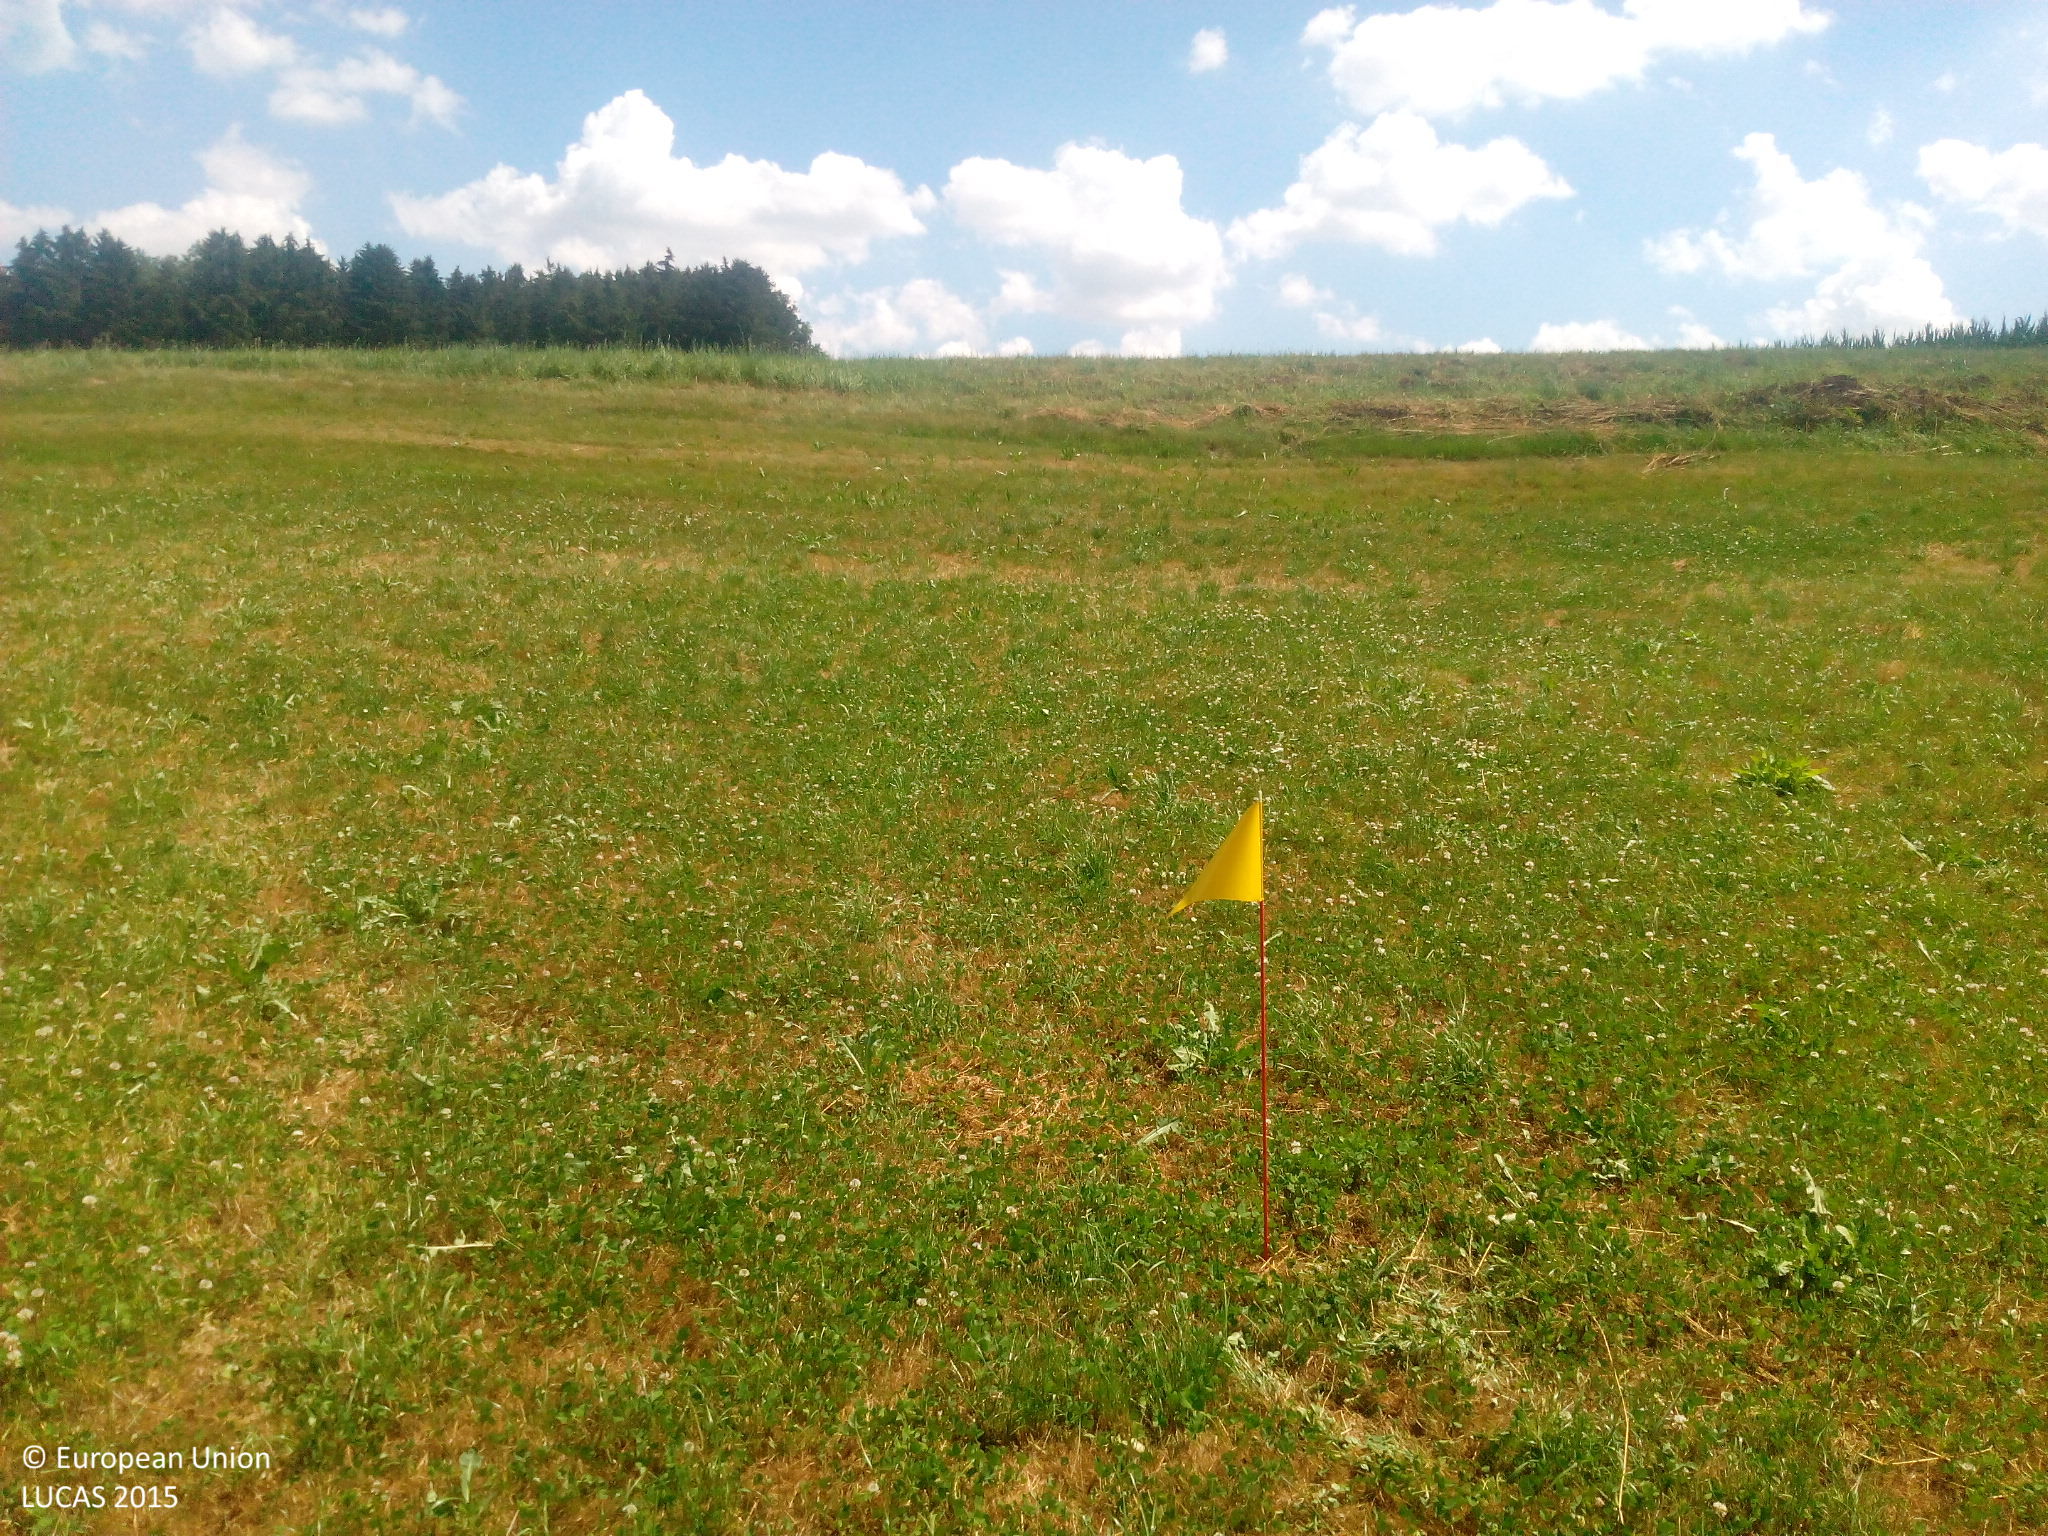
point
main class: Grassland
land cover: Grassland without tree/shrub cover
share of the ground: > 75 %
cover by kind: herbaceous plants 100 %
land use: Agriculture (excluding fallow land and kitchen gardens)
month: July
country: DE
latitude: 48.1859
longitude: 10.6049
